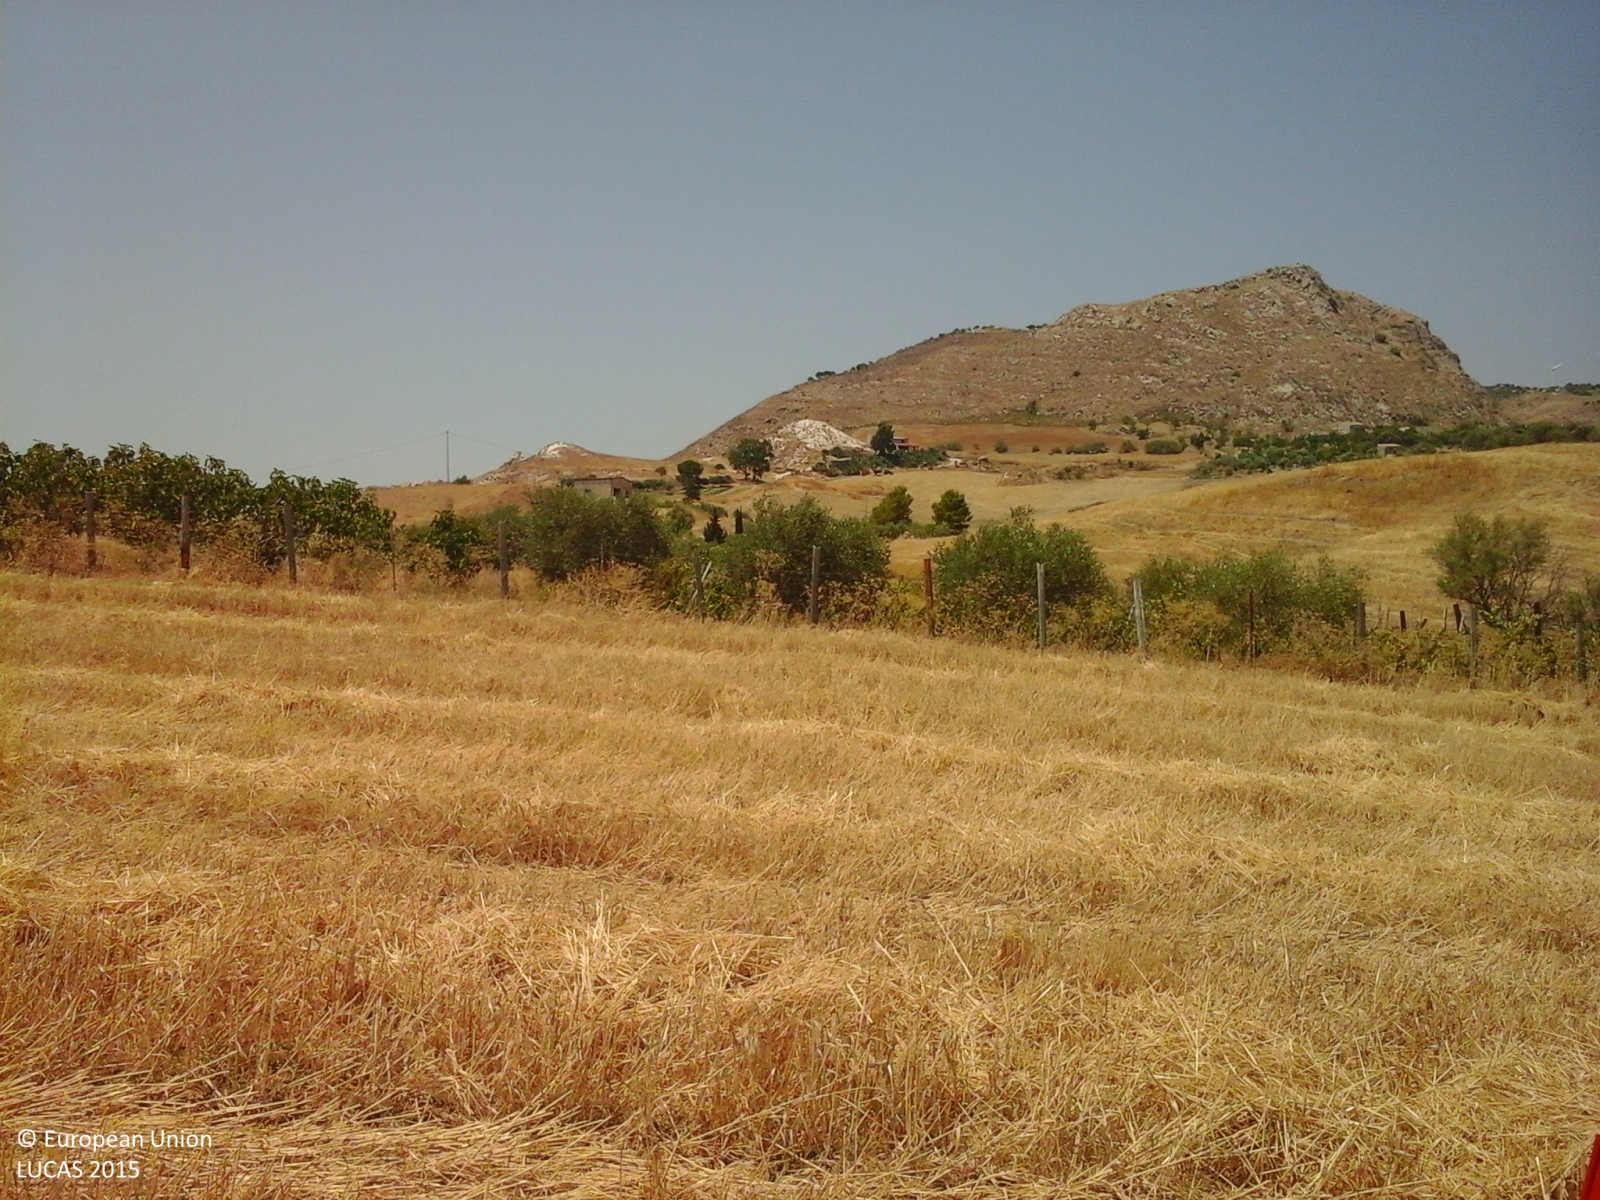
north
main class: Cropland
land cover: Durum wheat
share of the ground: > 75 %
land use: Agriculture (excluding fallow land and kitchen gardens)
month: July
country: IT
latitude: 37.3937
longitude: 13.4635
